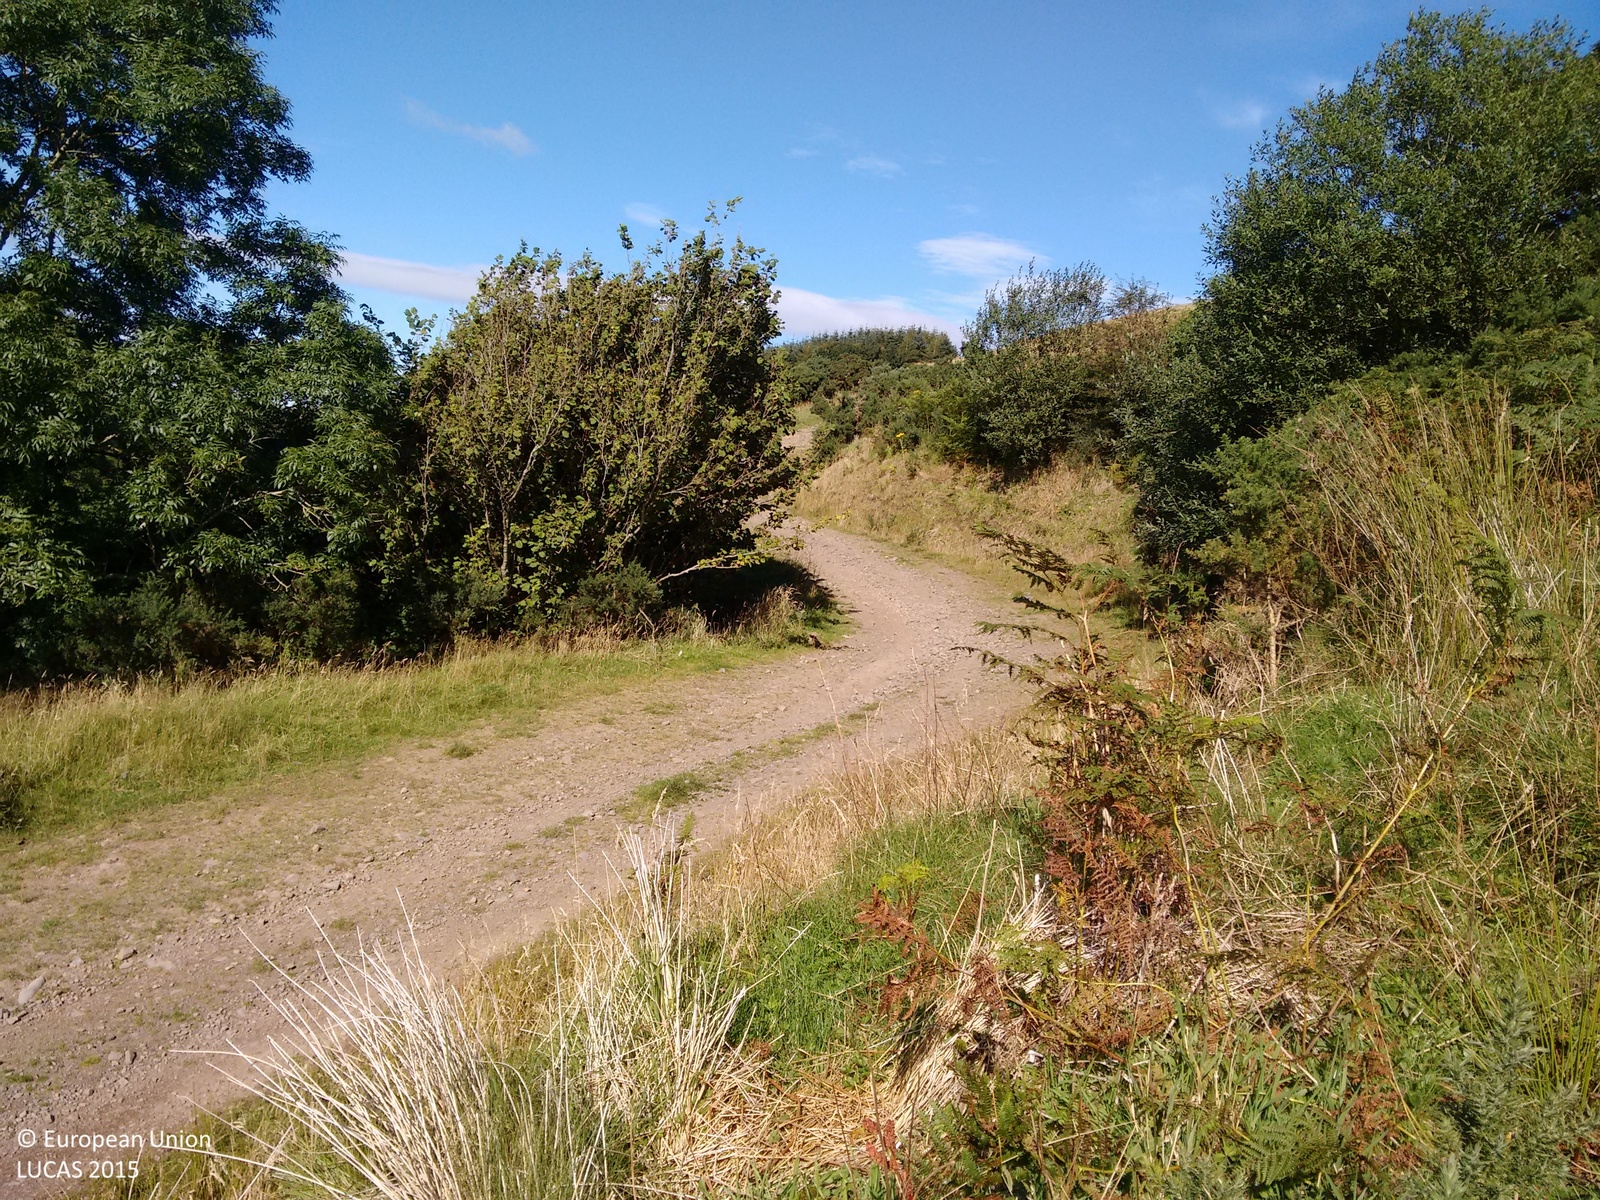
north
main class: Grassland
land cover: Grassland without tree/shrub cover
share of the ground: > 75 %
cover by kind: herbaceous plants 100 %
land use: Agriculture (excluding fallow land and kitchen gardens)
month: September
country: GB
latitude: 55.1562
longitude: -4.8139
